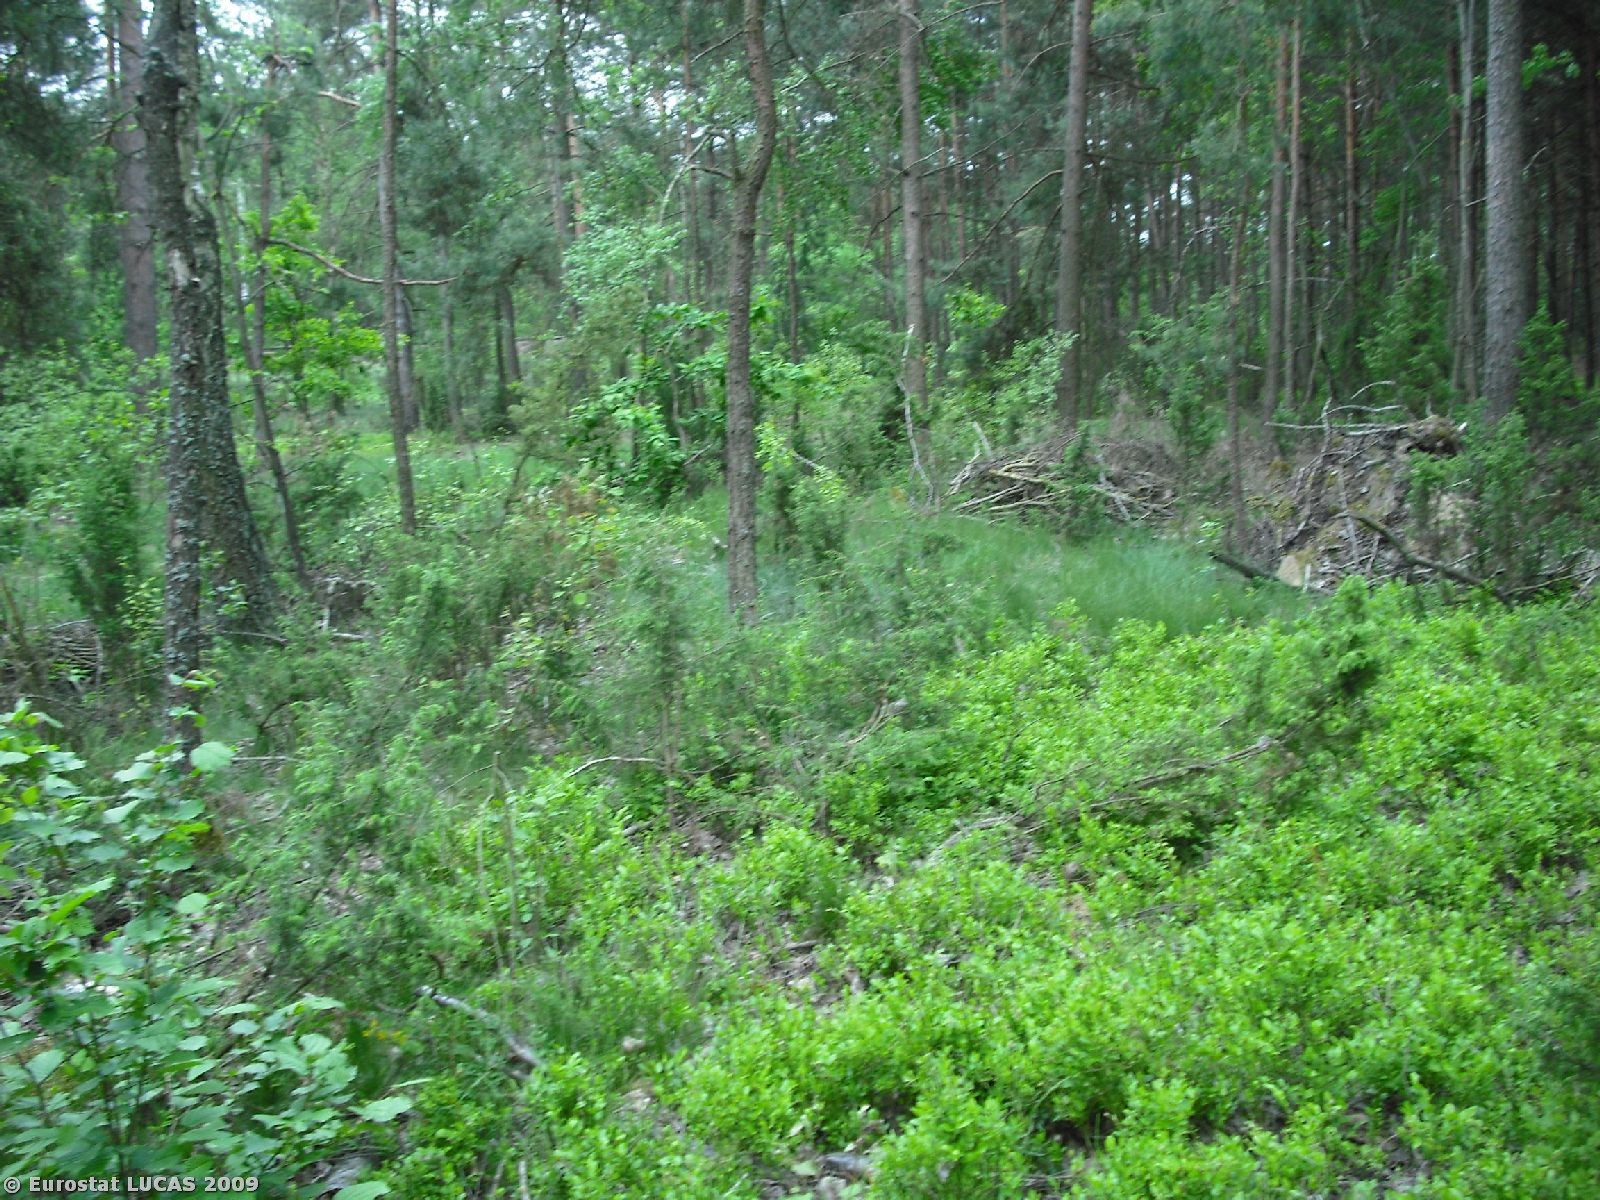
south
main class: Woodland
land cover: Mixed woodland
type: hemiboreal forest and nemoral coniferous forest and mixed broadleaved-coniferous forest
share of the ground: 50 - 75 %
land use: Forestry
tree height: > 5 m
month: May
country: PL
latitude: 52.8313
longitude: 22.4289
